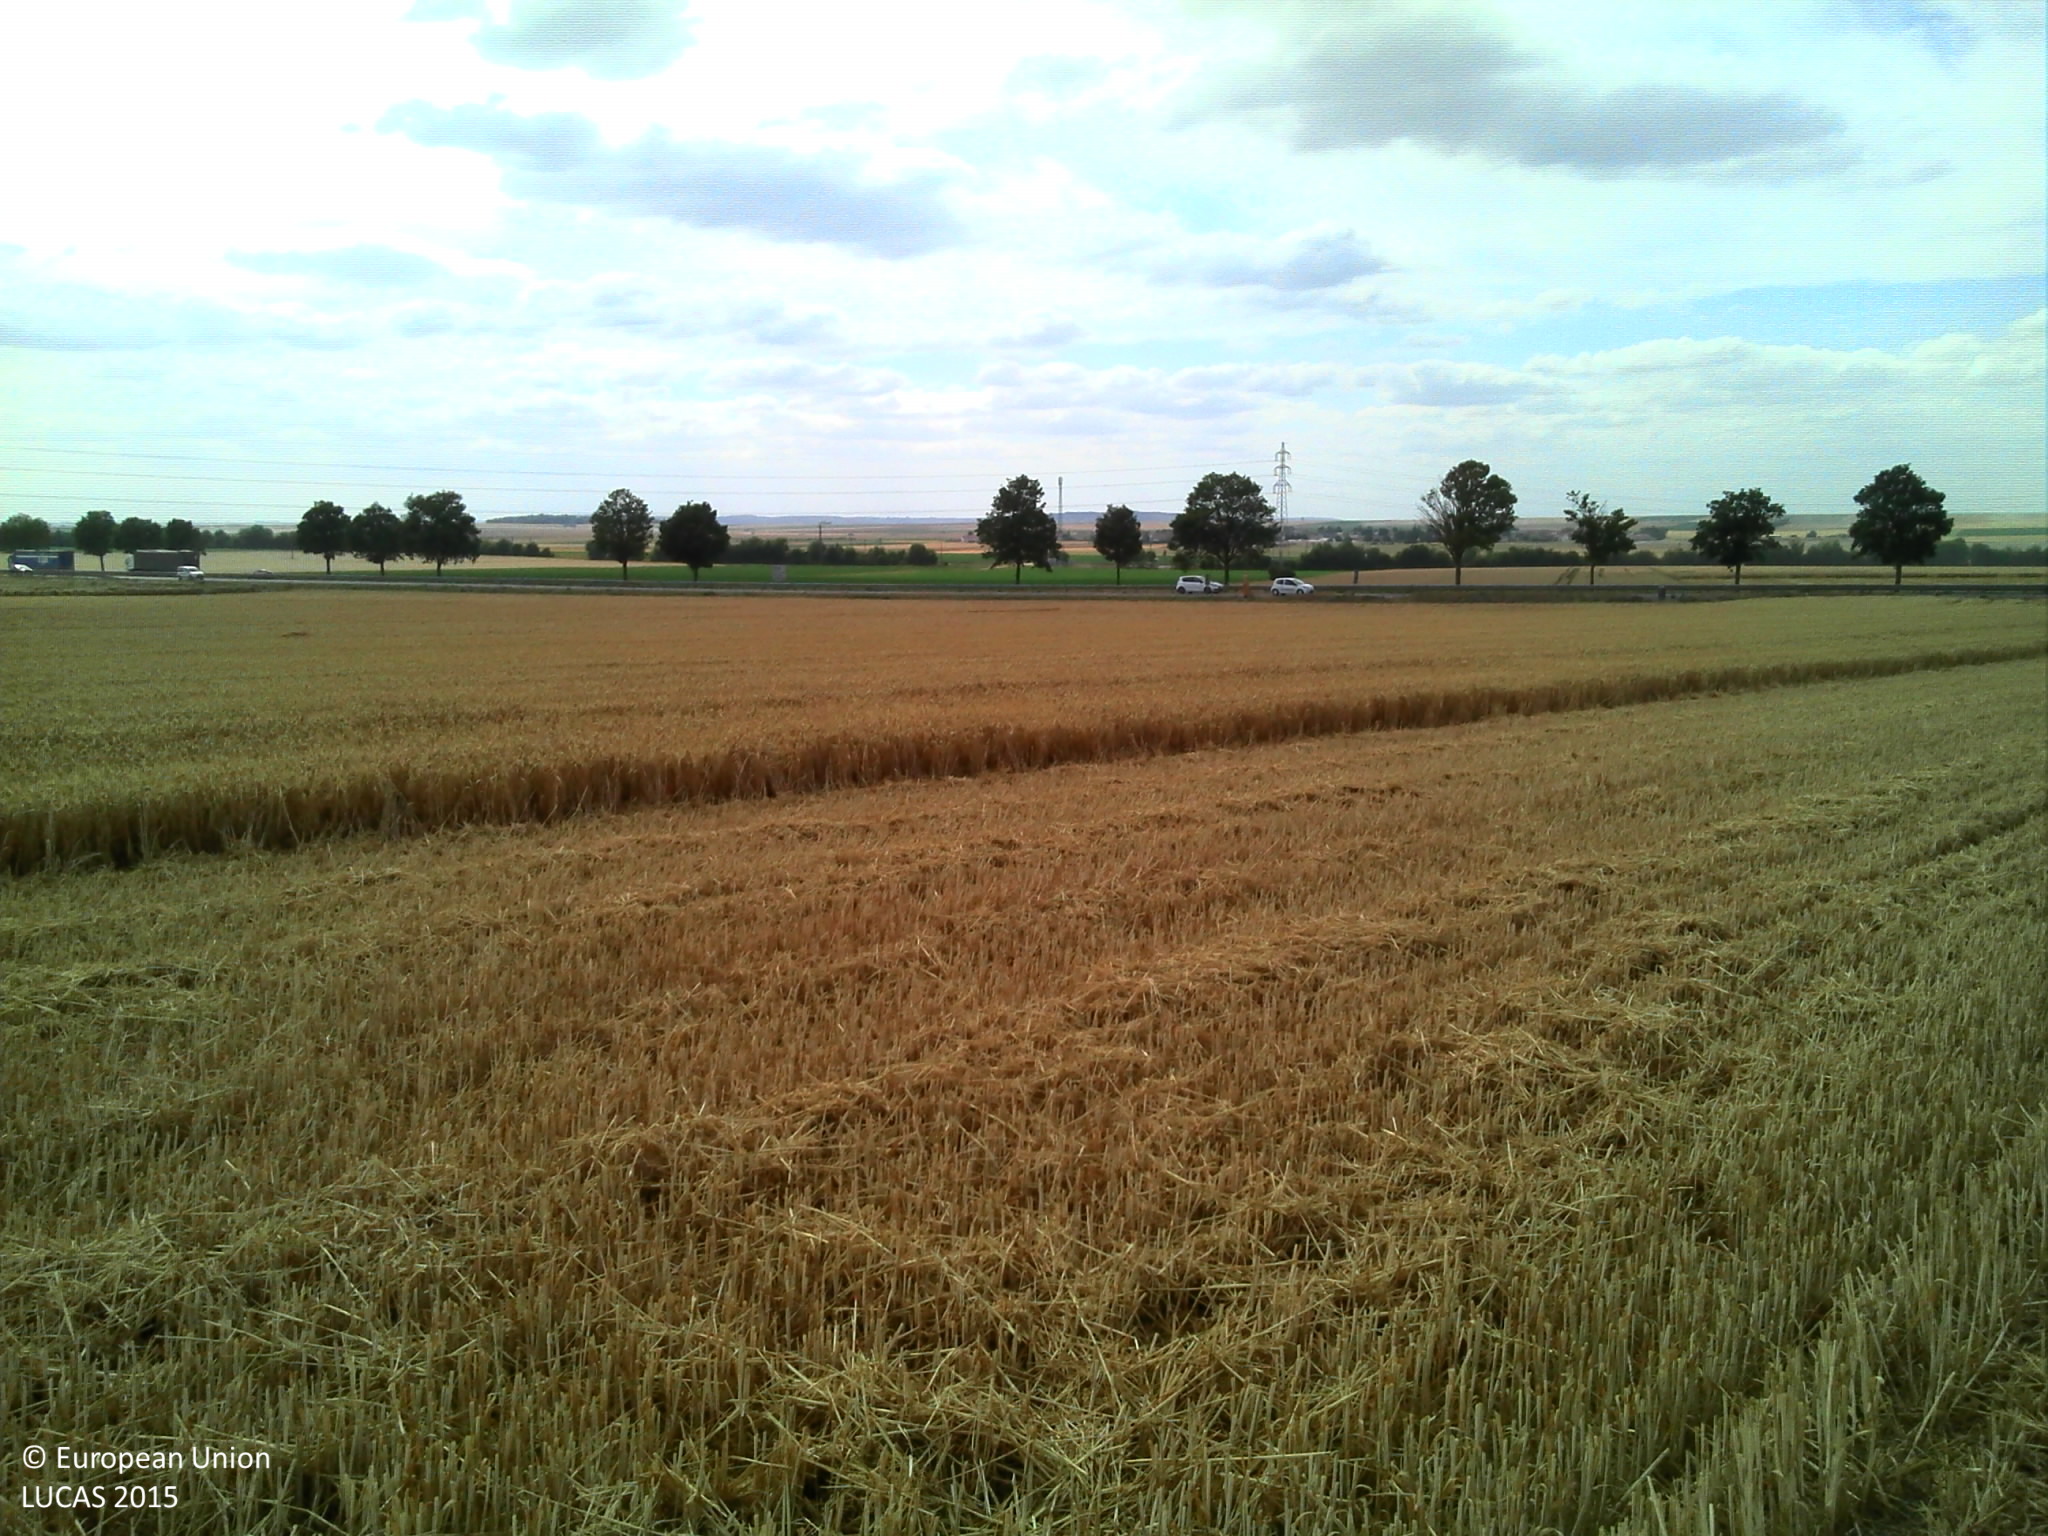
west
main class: Cropland
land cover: Common wheat
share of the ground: > 75 %
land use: Agriculture (excluding fallow land and kitchen gardens)
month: July
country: FR
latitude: 49.3321
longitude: 4.1746
